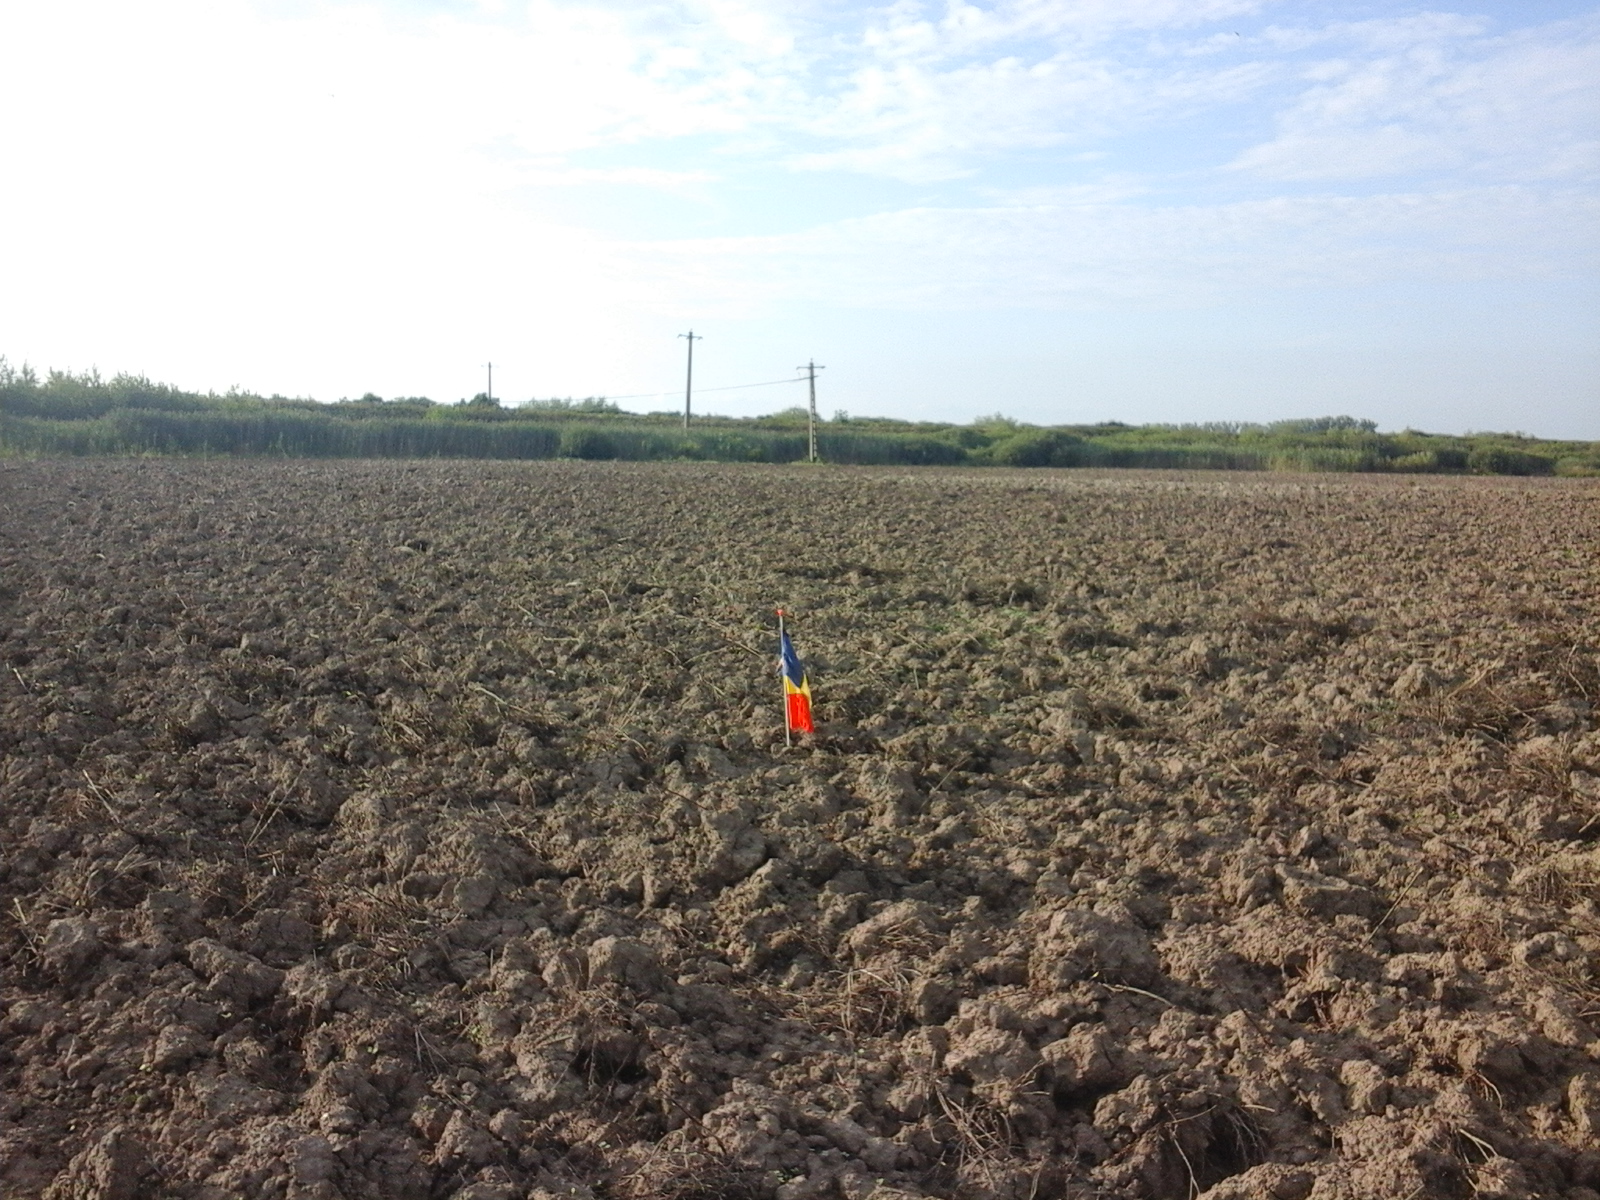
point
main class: Cropland
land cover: Rape and turnip rape
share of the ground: < 10 %
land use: Agriculture (excluding fallow land and kitchen gardens)
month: August
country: RO
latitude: 46.6628
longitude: 21.6063
